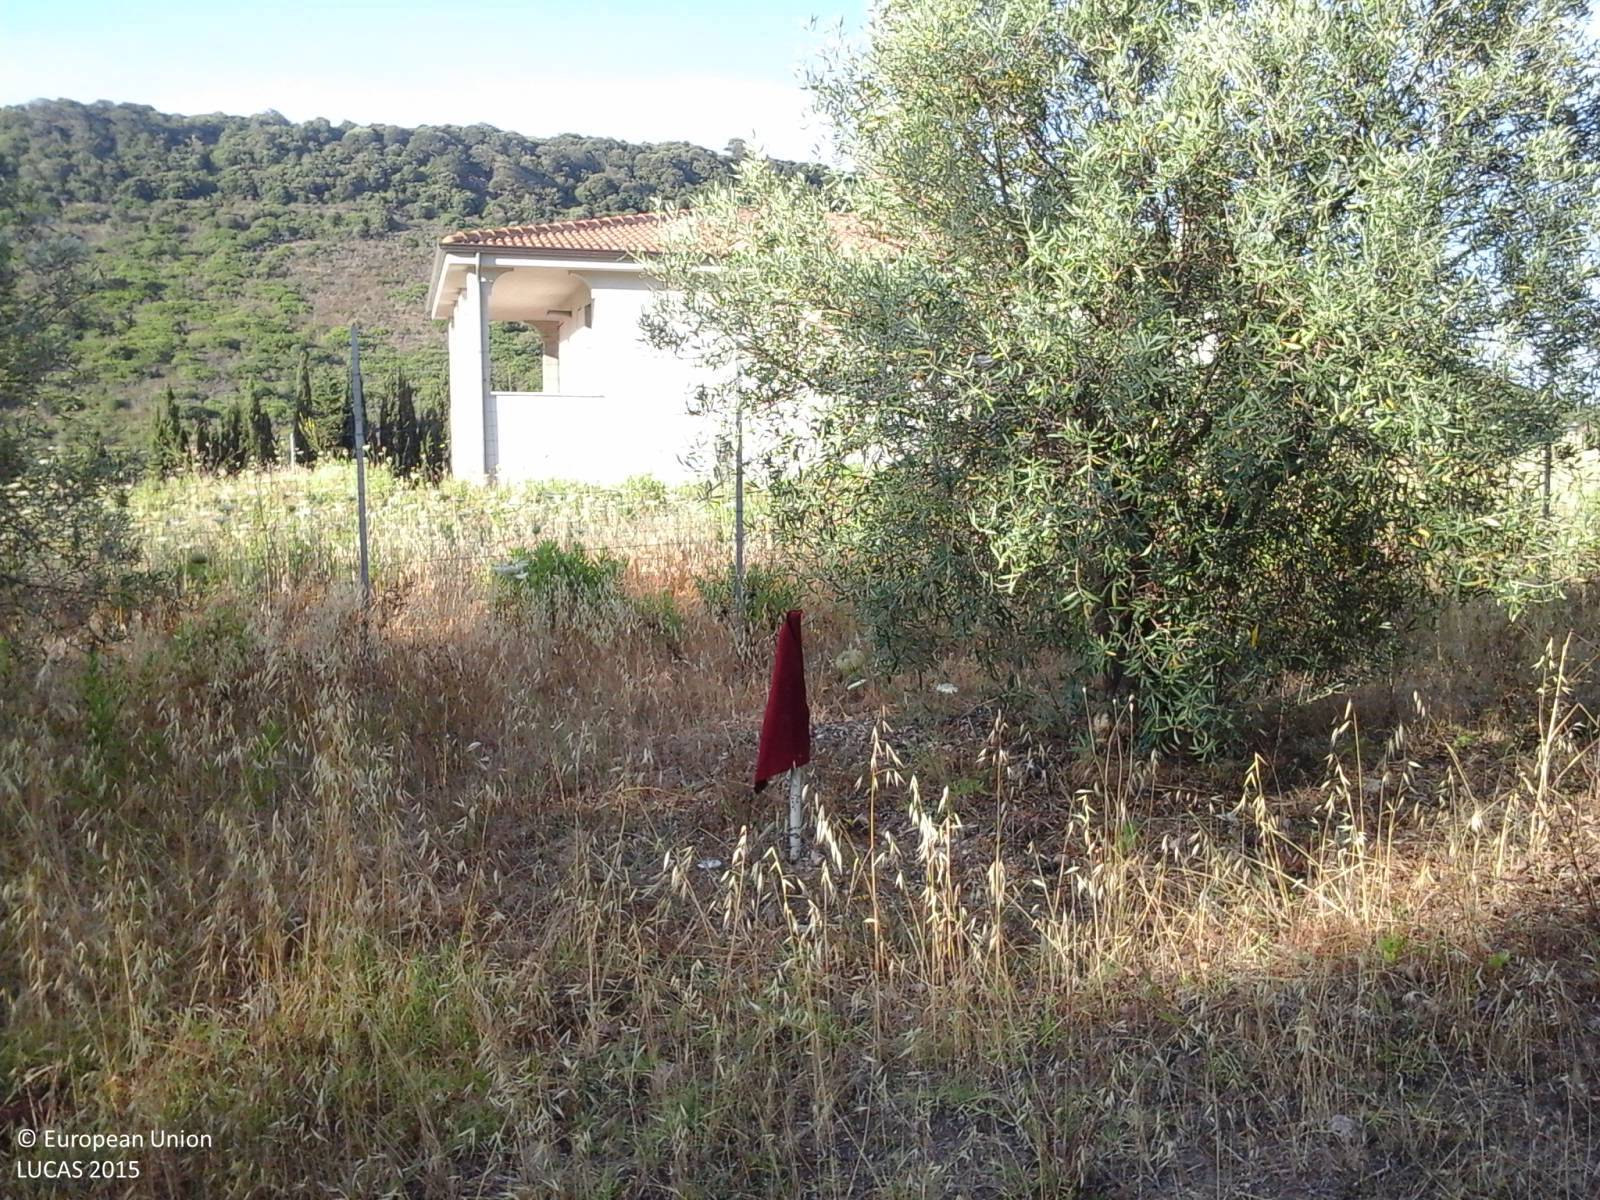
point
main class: Cropland
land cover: Olive groves
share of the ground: < 10 %
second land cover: Grassland without tree/shrub cover
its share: 50 - 75 %
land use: Agriculture (excluding fallow land and kitchen gardens)
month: June
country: IT
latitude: 40.5800
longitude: 8.3894
